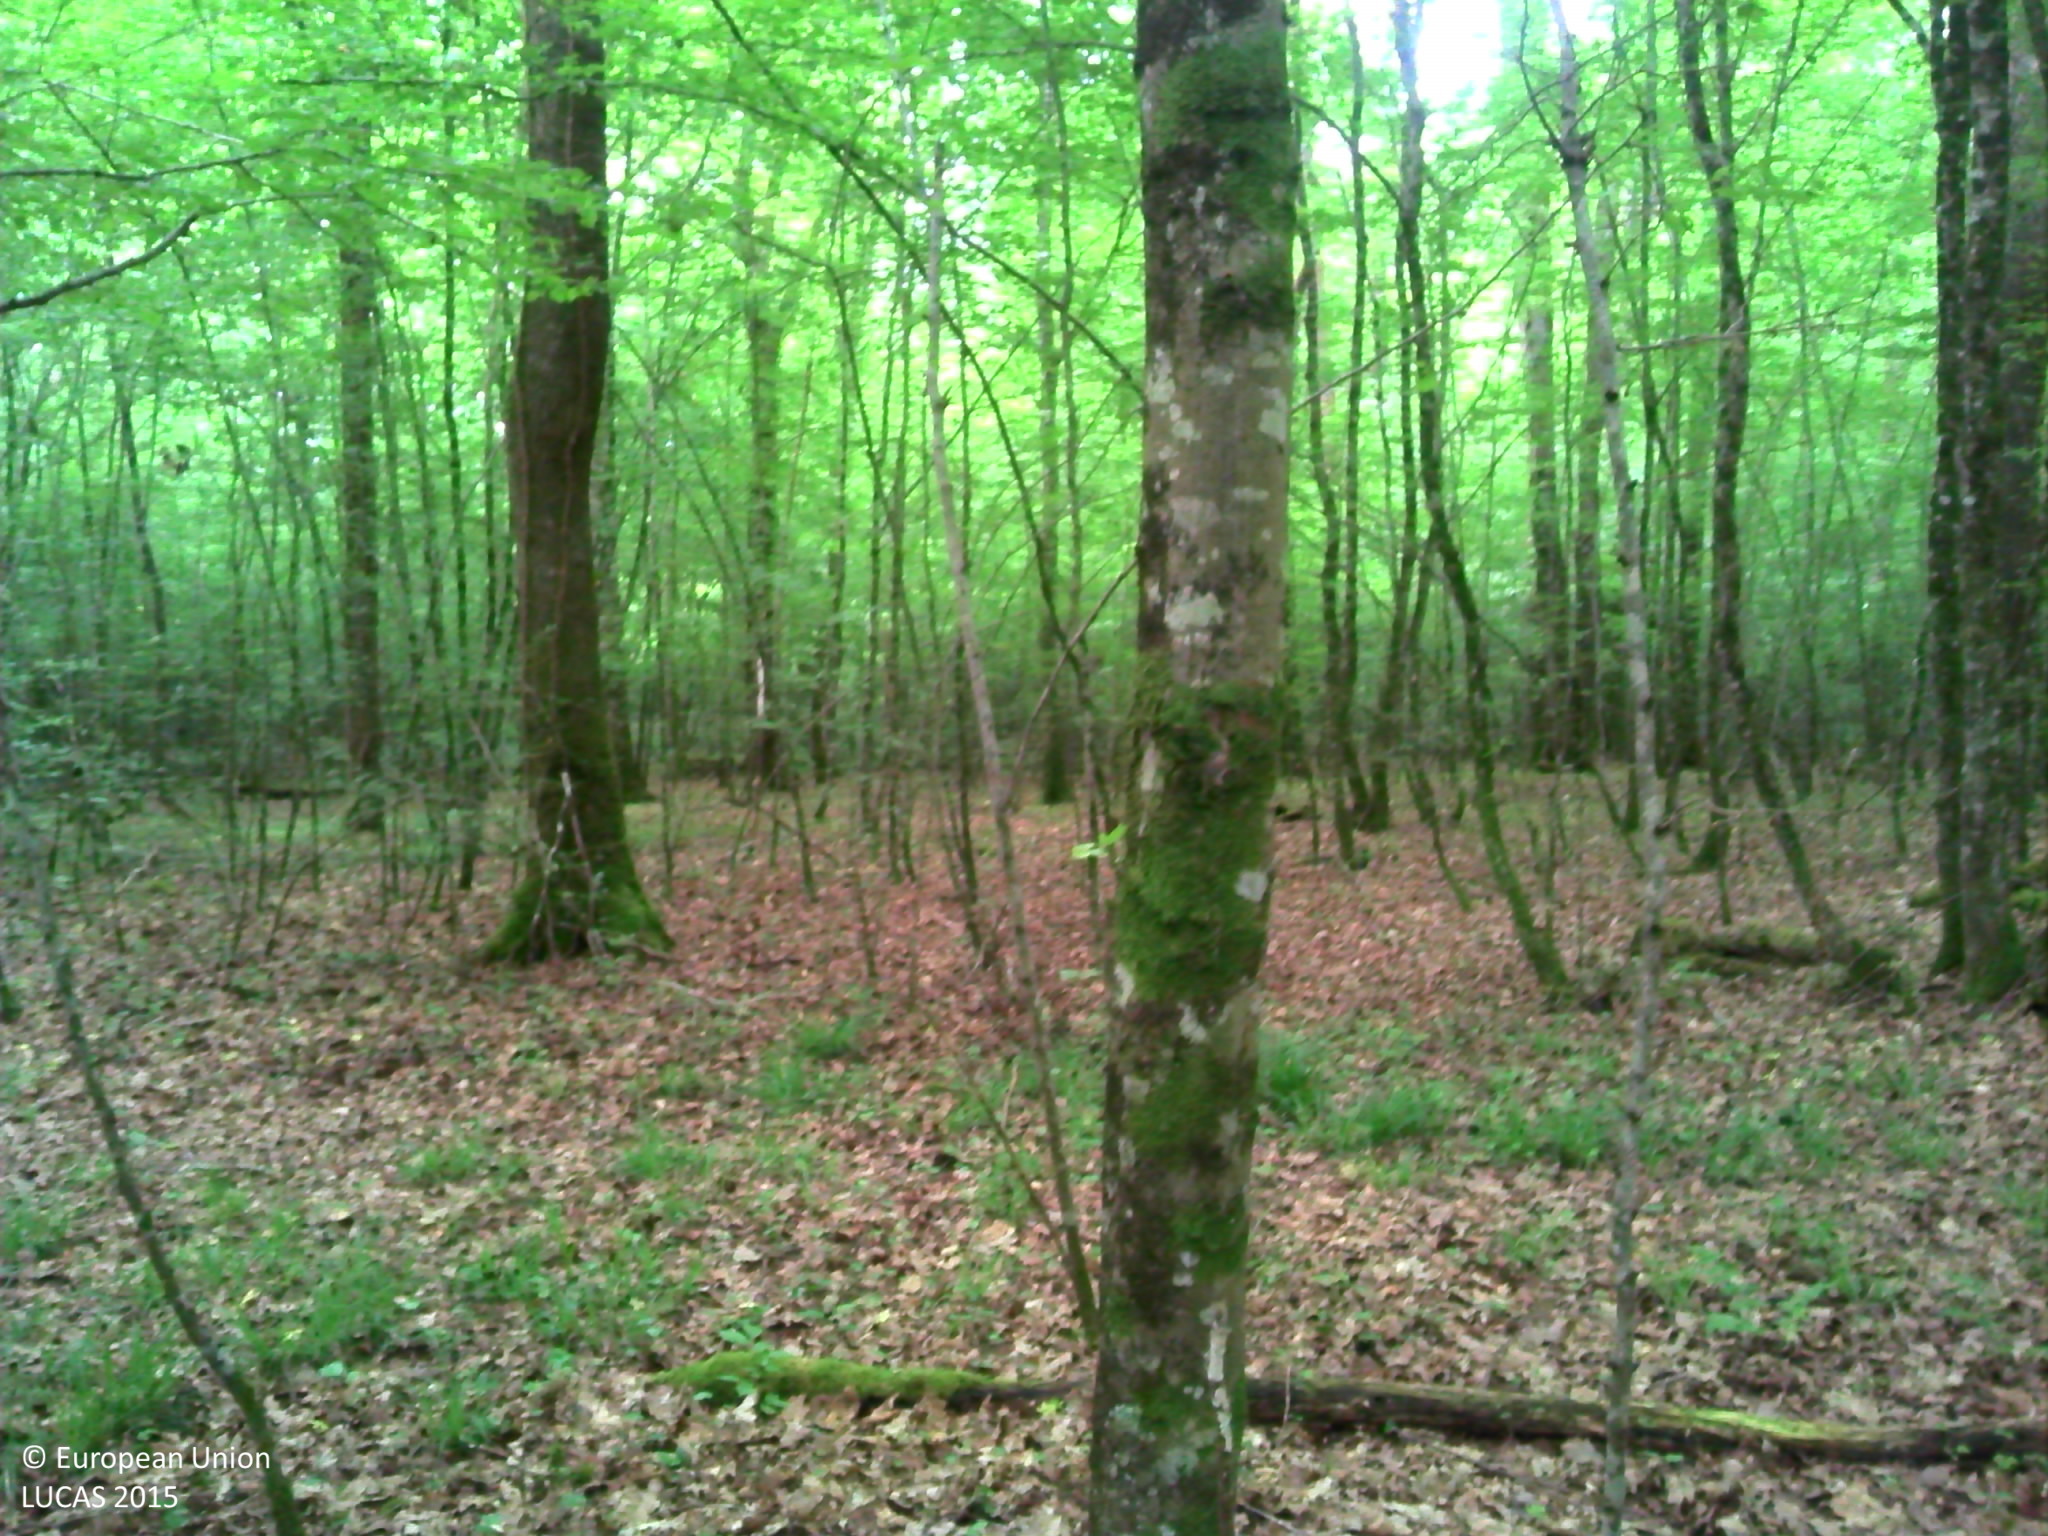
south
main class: Woodland
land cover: Broadleaved woodland
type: mesophytic deciduous forest
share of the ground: > 75 %
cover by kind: broadleaved forest trees 90 %, herbaceous plants 10 %
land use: Forestry
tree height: > 5 m
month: June
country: FR
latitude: 48.5404
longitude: 4.9462
